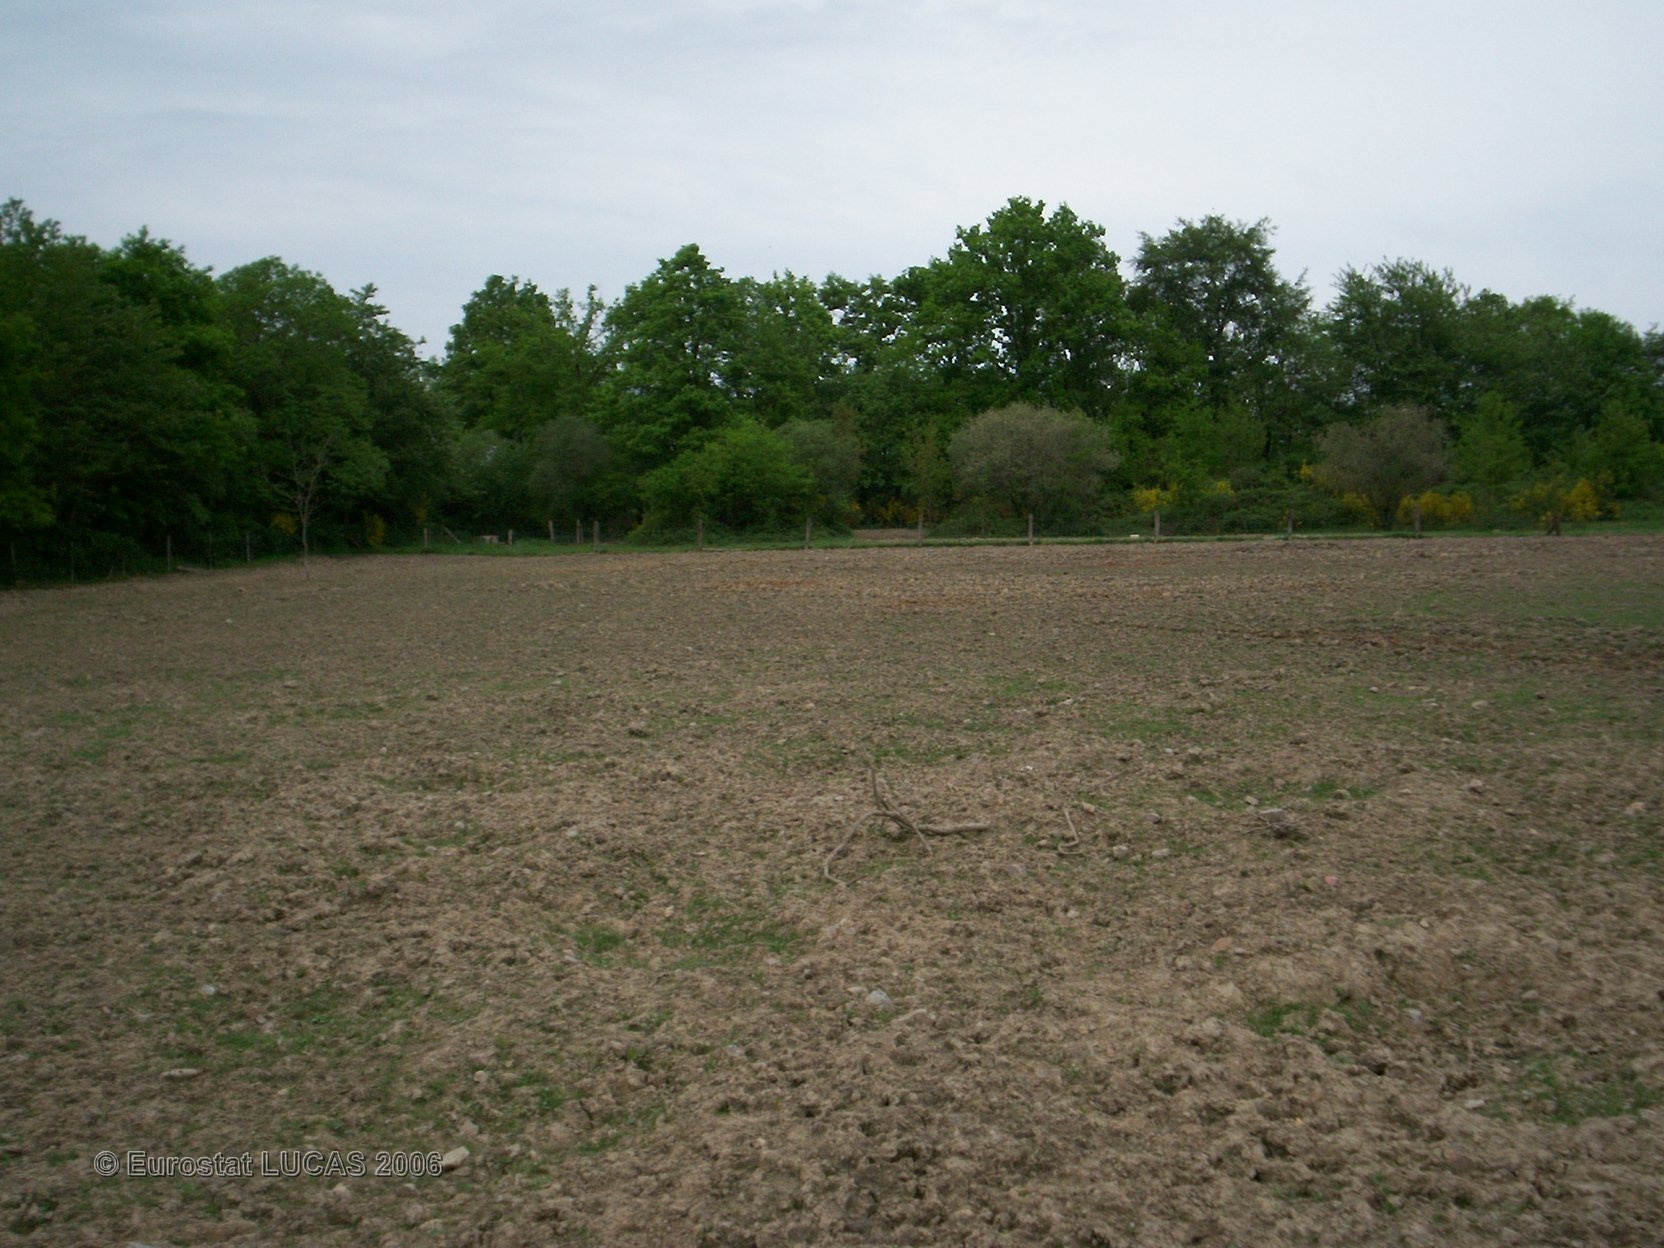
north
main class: Grassland
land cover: Grassland with sparse tree/shrub cover
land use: Agriculture (excluding fallow land and kitchen gardens)
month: May
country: FR
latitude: 48.3471
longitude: -1.6664
